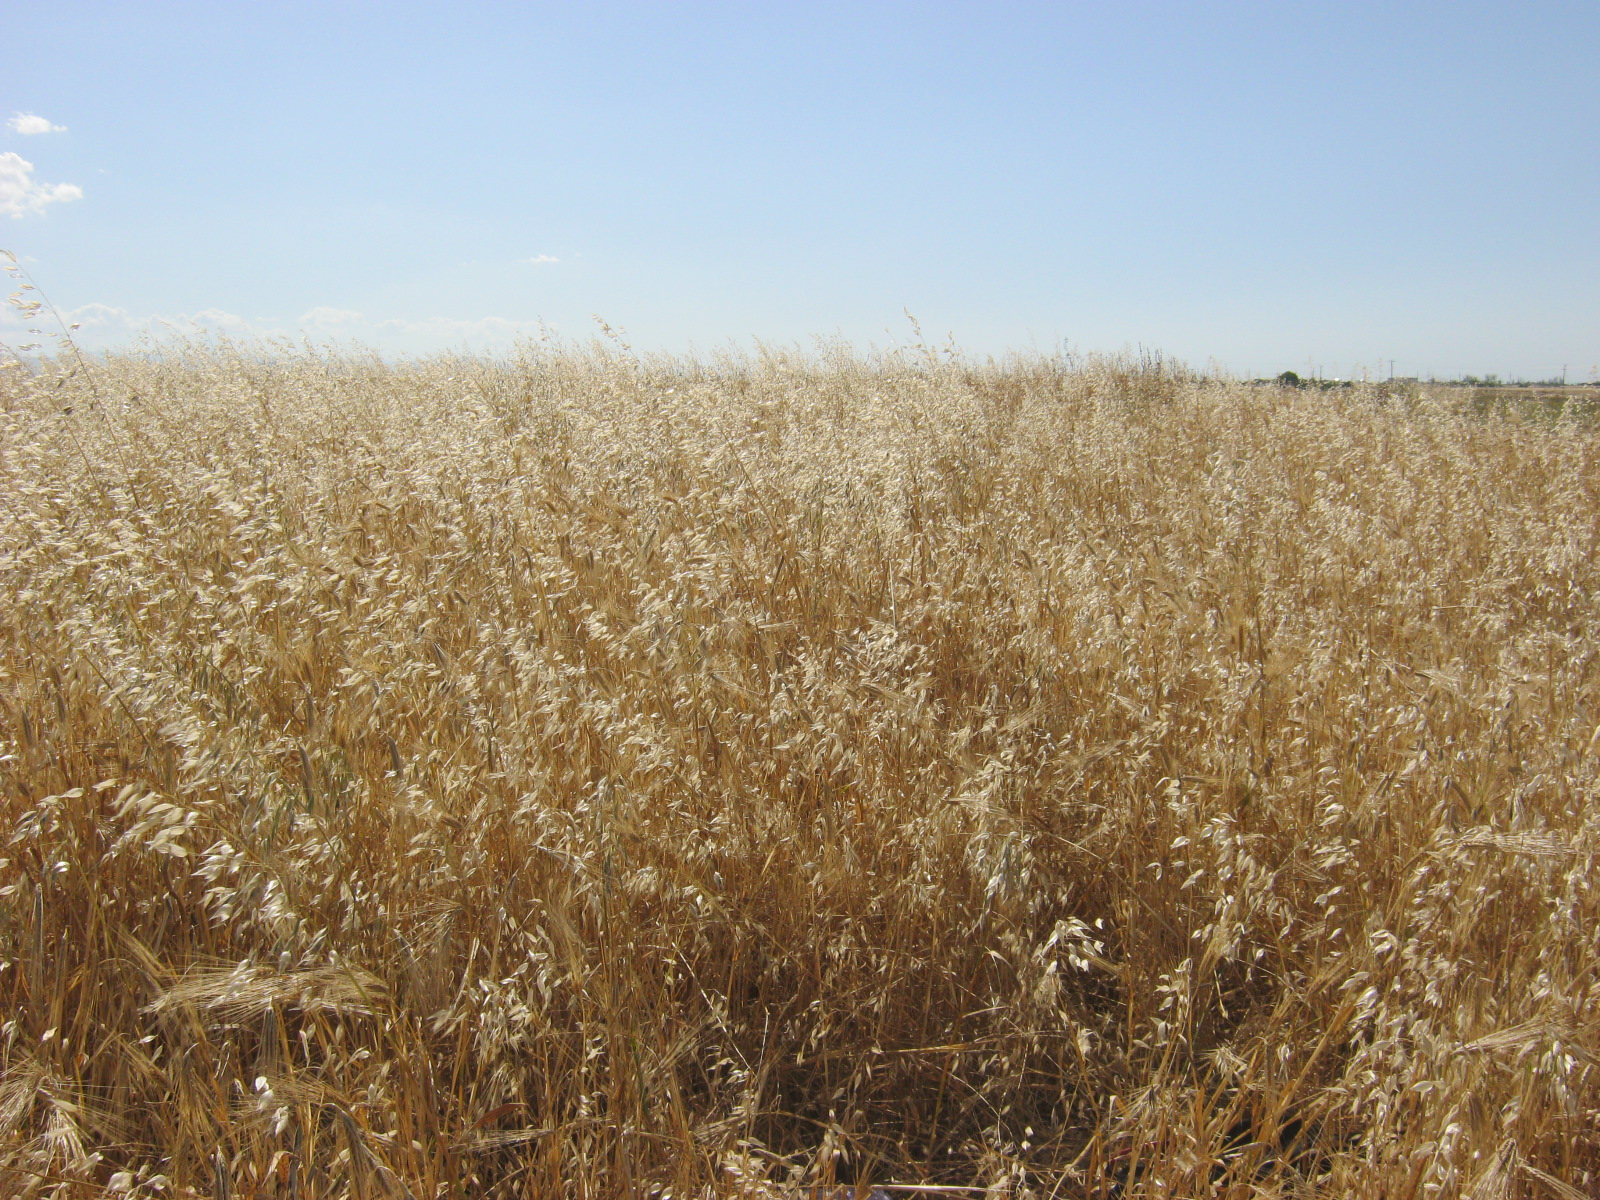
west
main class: Cropland
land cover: Barley
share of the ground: > 75 %
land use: Agriculture (excluding fallow land and kitchen gardens)
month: May
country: CY
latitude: 35.1244
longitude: 33.1742
